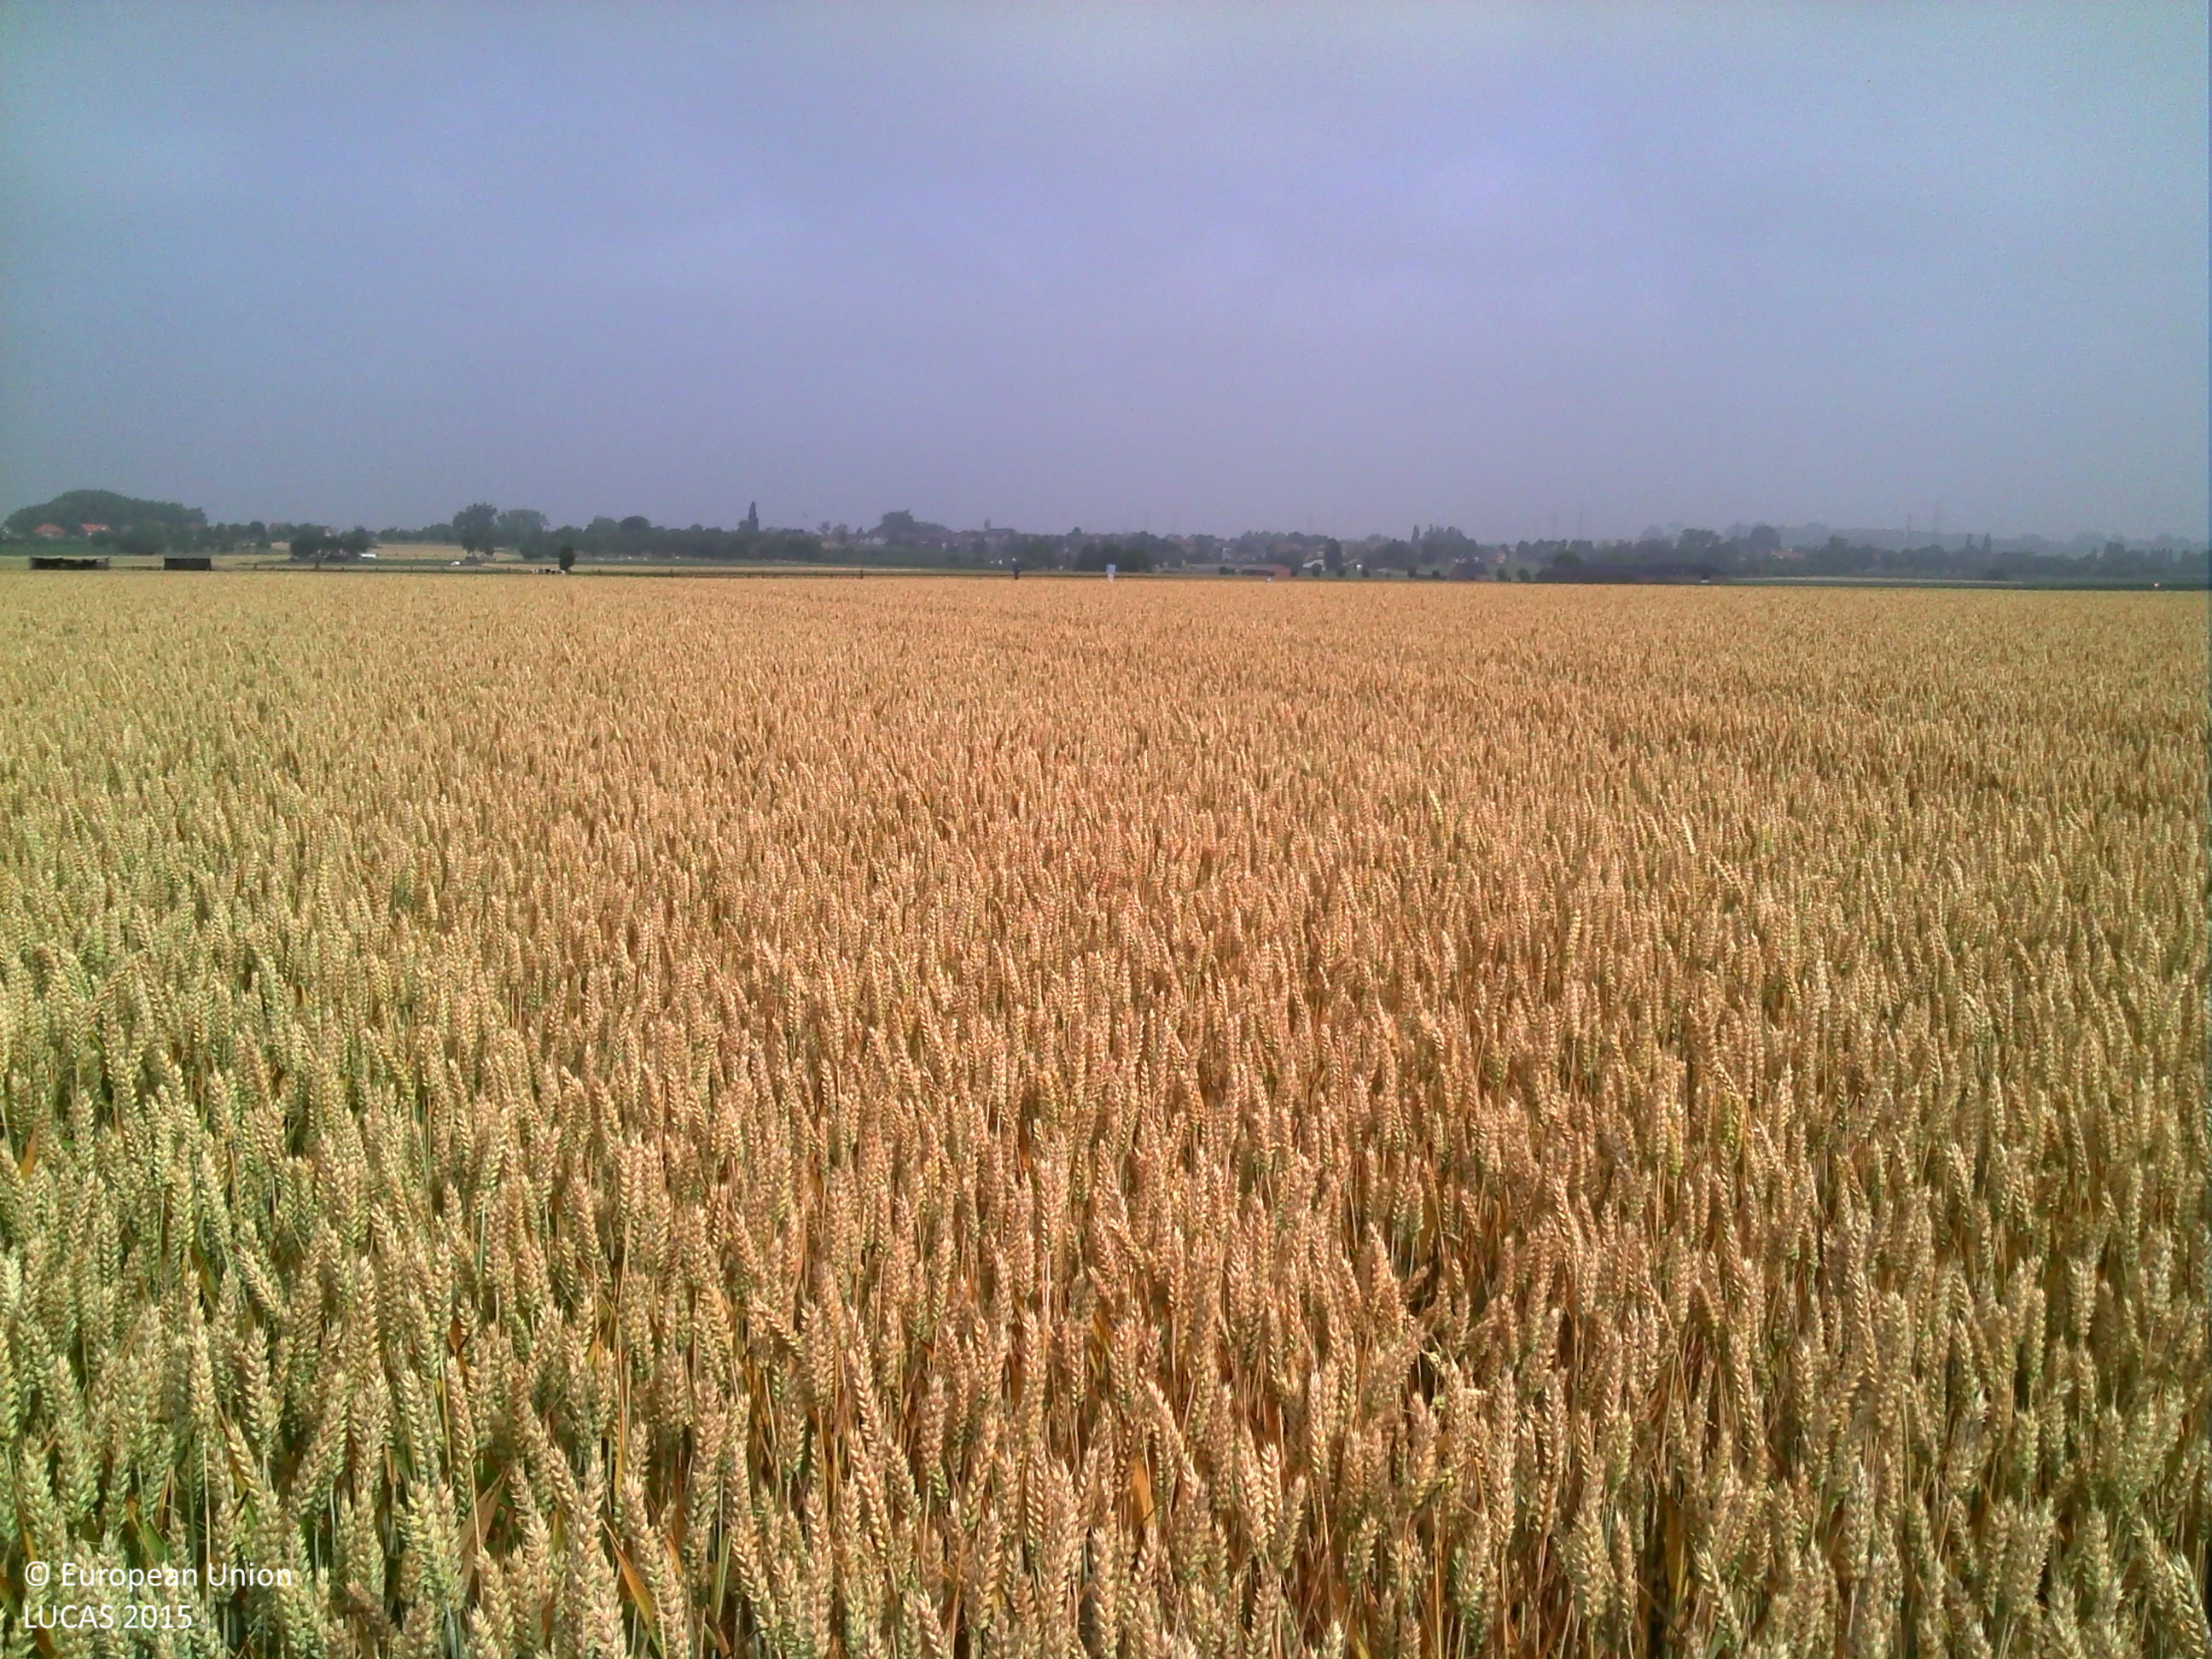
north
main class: Cropland
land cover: Common wheat
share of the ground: > 75 %
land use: Agriculture (excluding fallow land and kitchen gardens)
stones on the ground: < 10 %
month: July
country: BE
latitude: 50.8180
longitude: 5.5555
